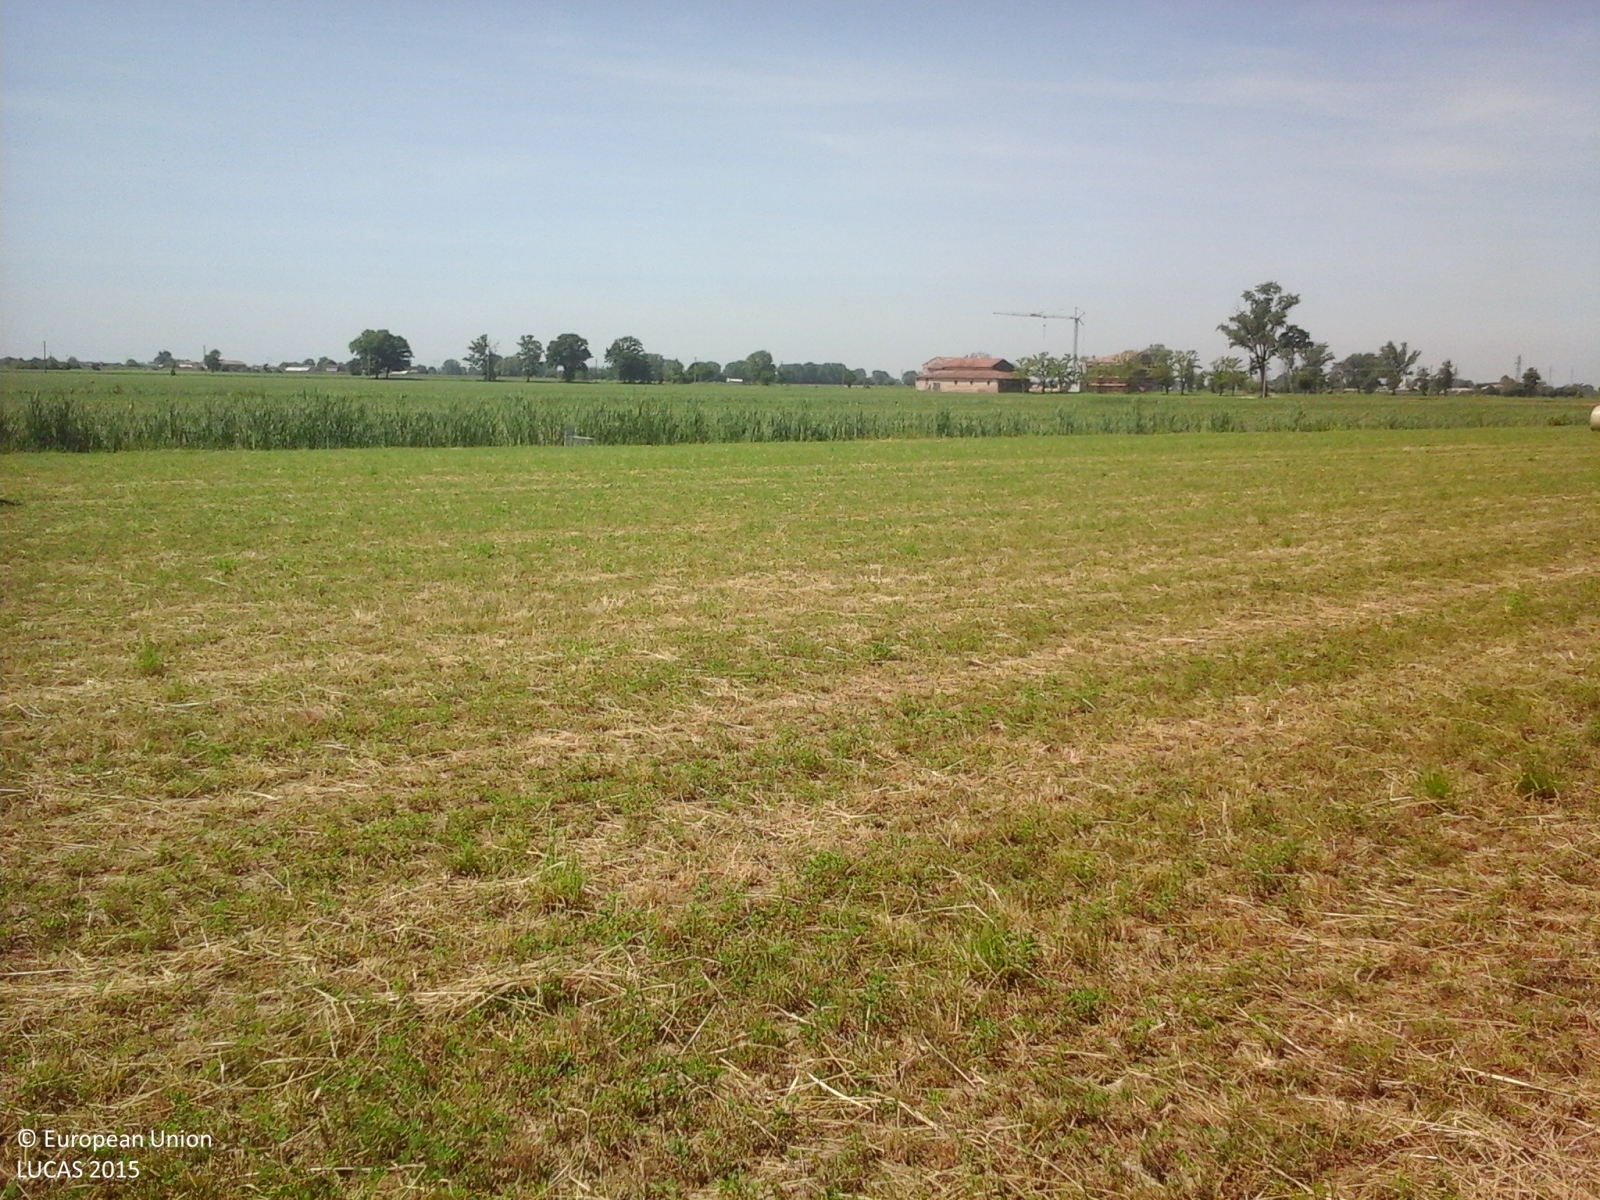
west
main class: Cropland
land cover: Lucerne
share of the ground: > 75 %
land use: Agriculture (excluding fallow land and kitchen gardens)
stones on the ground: < 10 %
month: May
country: IT
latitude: 44.9780
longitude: 10.8733
